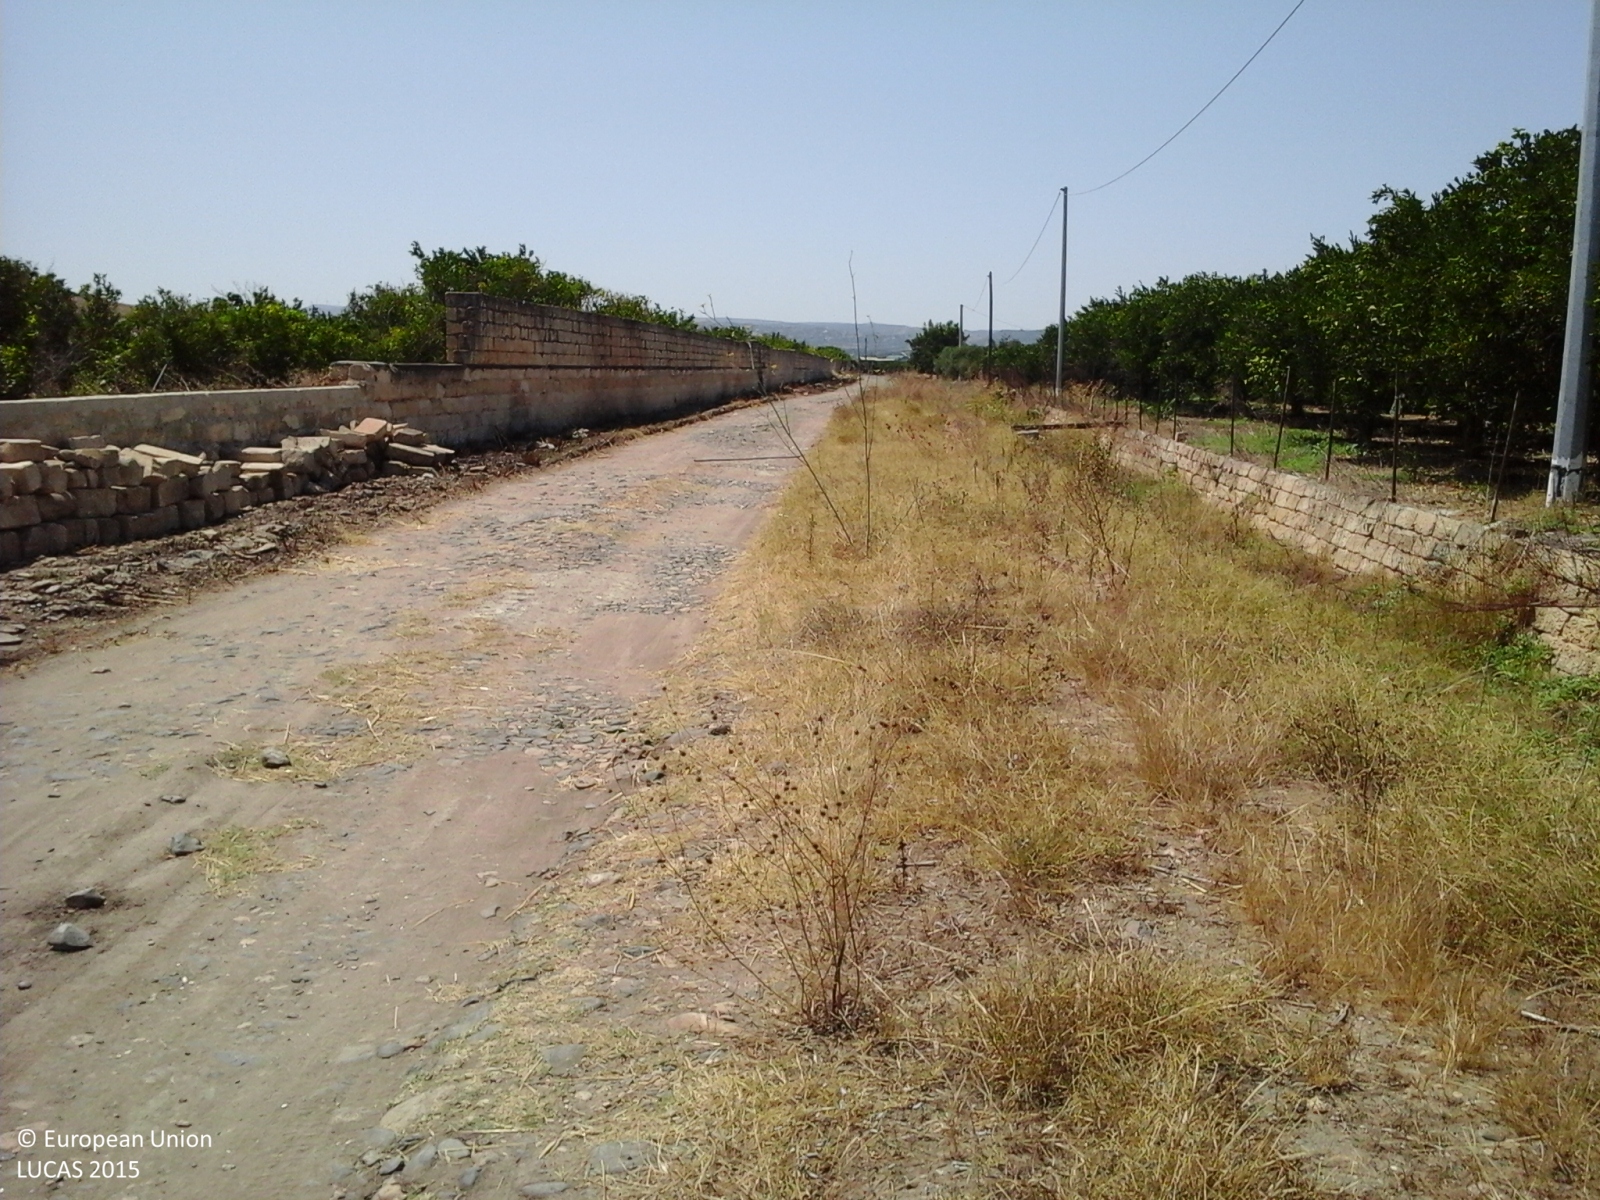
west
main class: Cropland
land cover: Oranges
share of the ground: > 75 %
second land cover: Spontaneously vegetated surfaces
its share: > 75 %
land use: Agriculture (excluding fallow land and kitchen gardens)
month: August
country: IT
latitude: 37.3123
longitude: 14.8944
